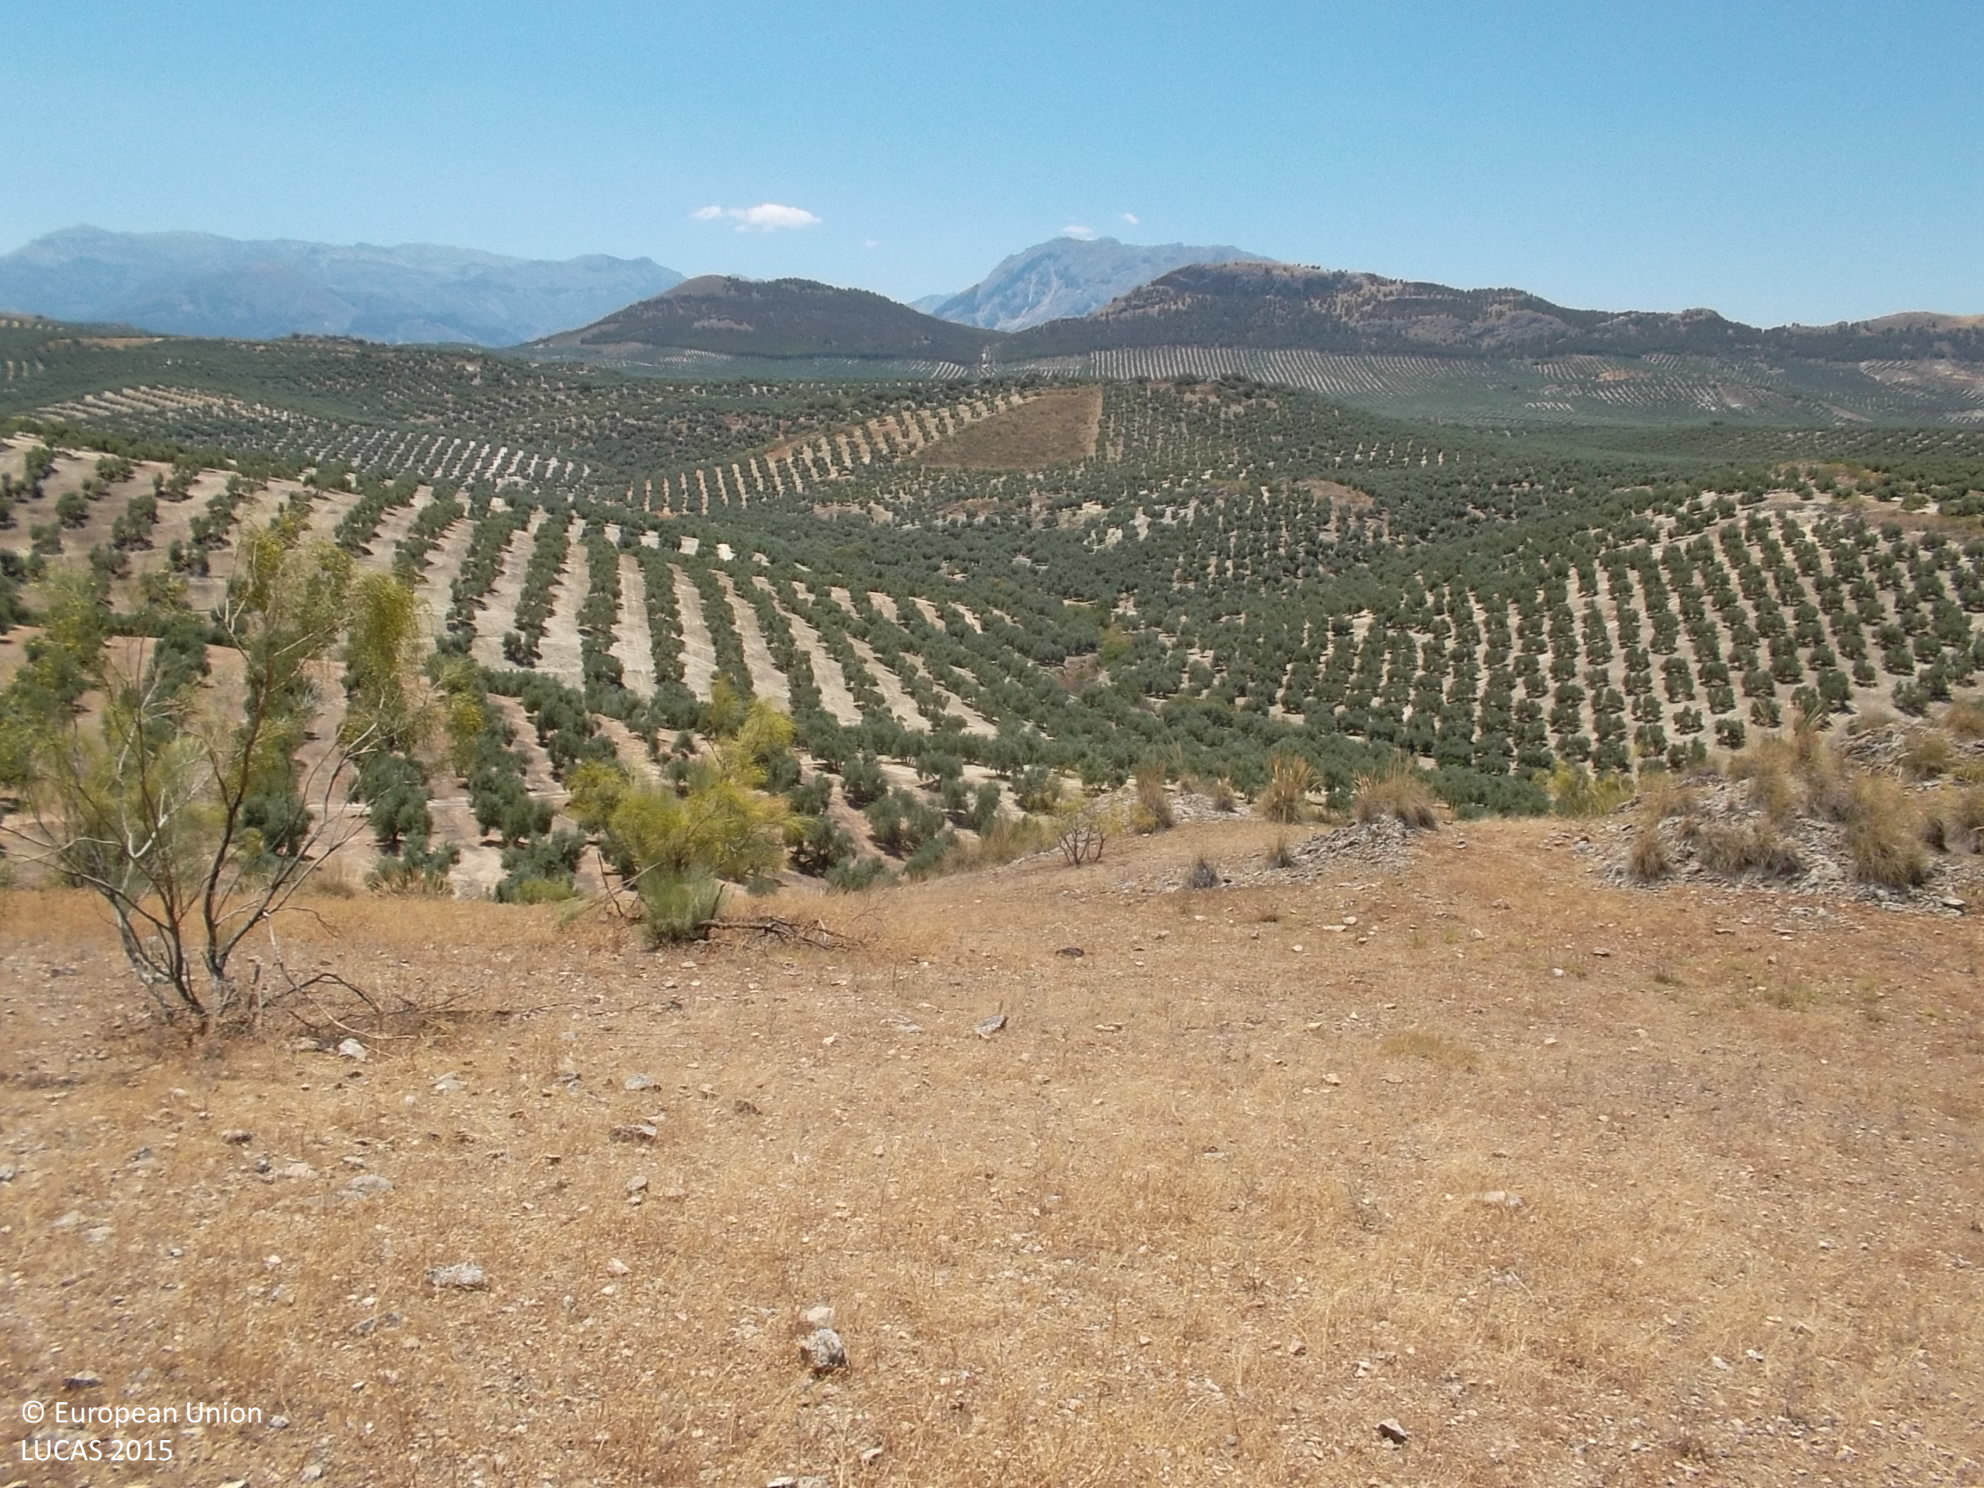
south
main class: Grassland
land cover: Grassland without tree/shrub cover
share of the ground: > 75 %
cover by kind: herbaceous plants 75 %, consolidated bare surface 20 %, shrubs 5 %
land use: Semi-natural and natural areas not in use
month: June
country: ES
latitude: 37.8947
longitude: -3.4058
